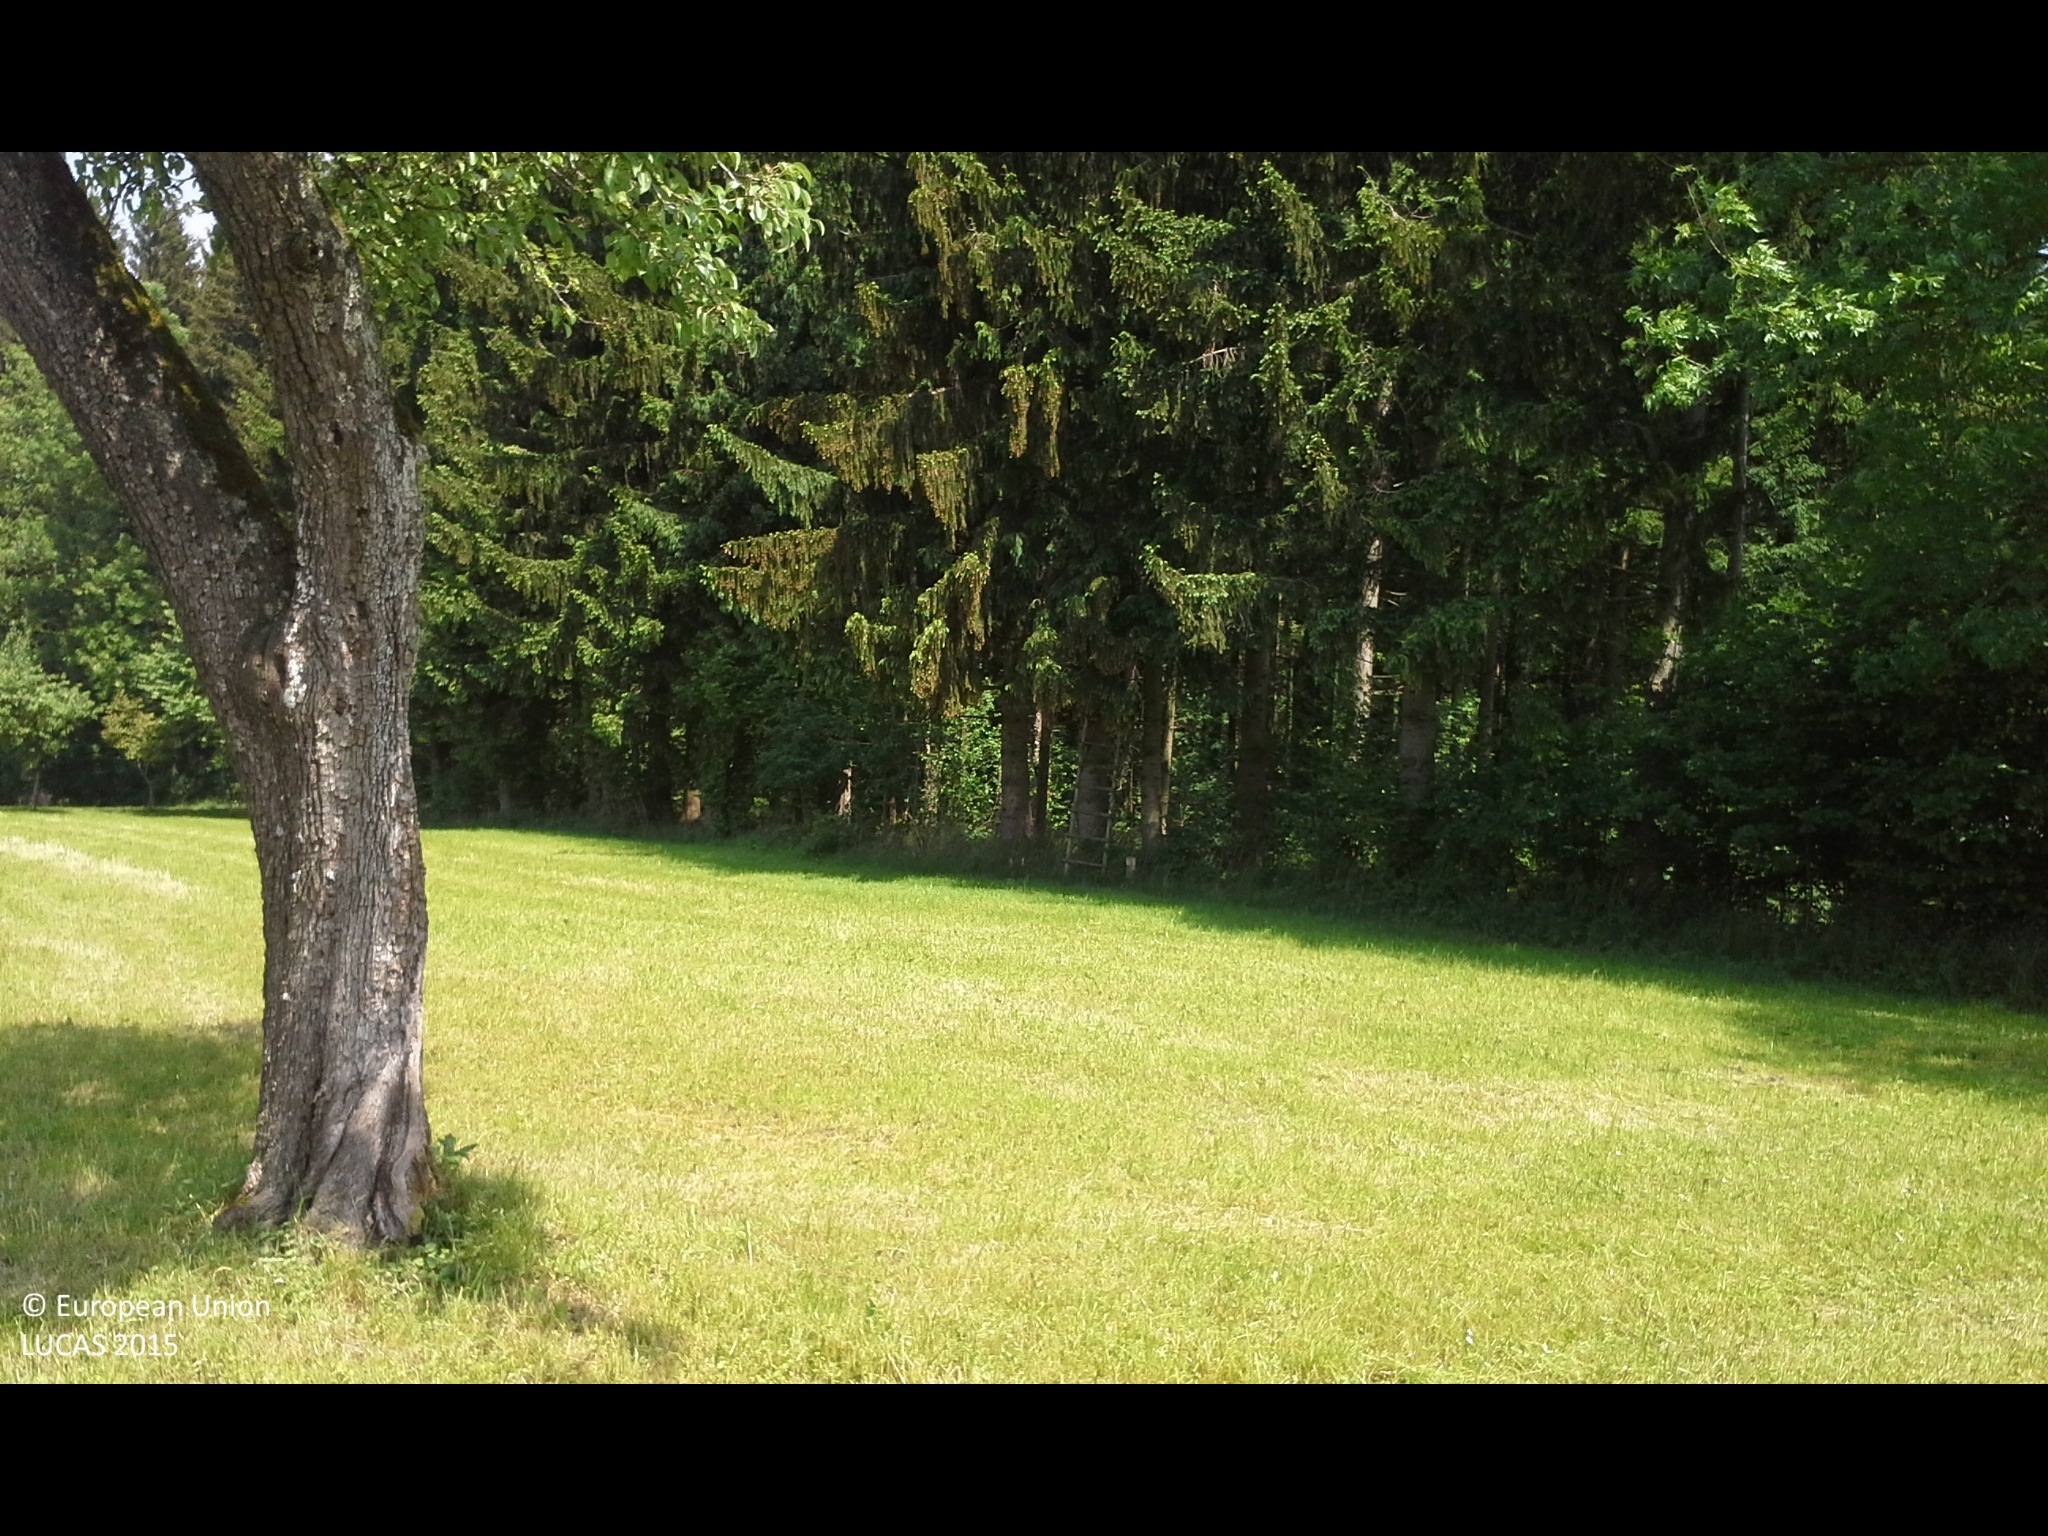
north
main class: Grassland
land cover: Grassland without tree/shrub cover
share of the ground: > 75 %
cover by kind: herbaceous plants 100 %
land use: Agriculture (excluding fallow land and kitchen gardens)
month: May
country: AT
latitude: 47.9806
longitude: 14.2199
